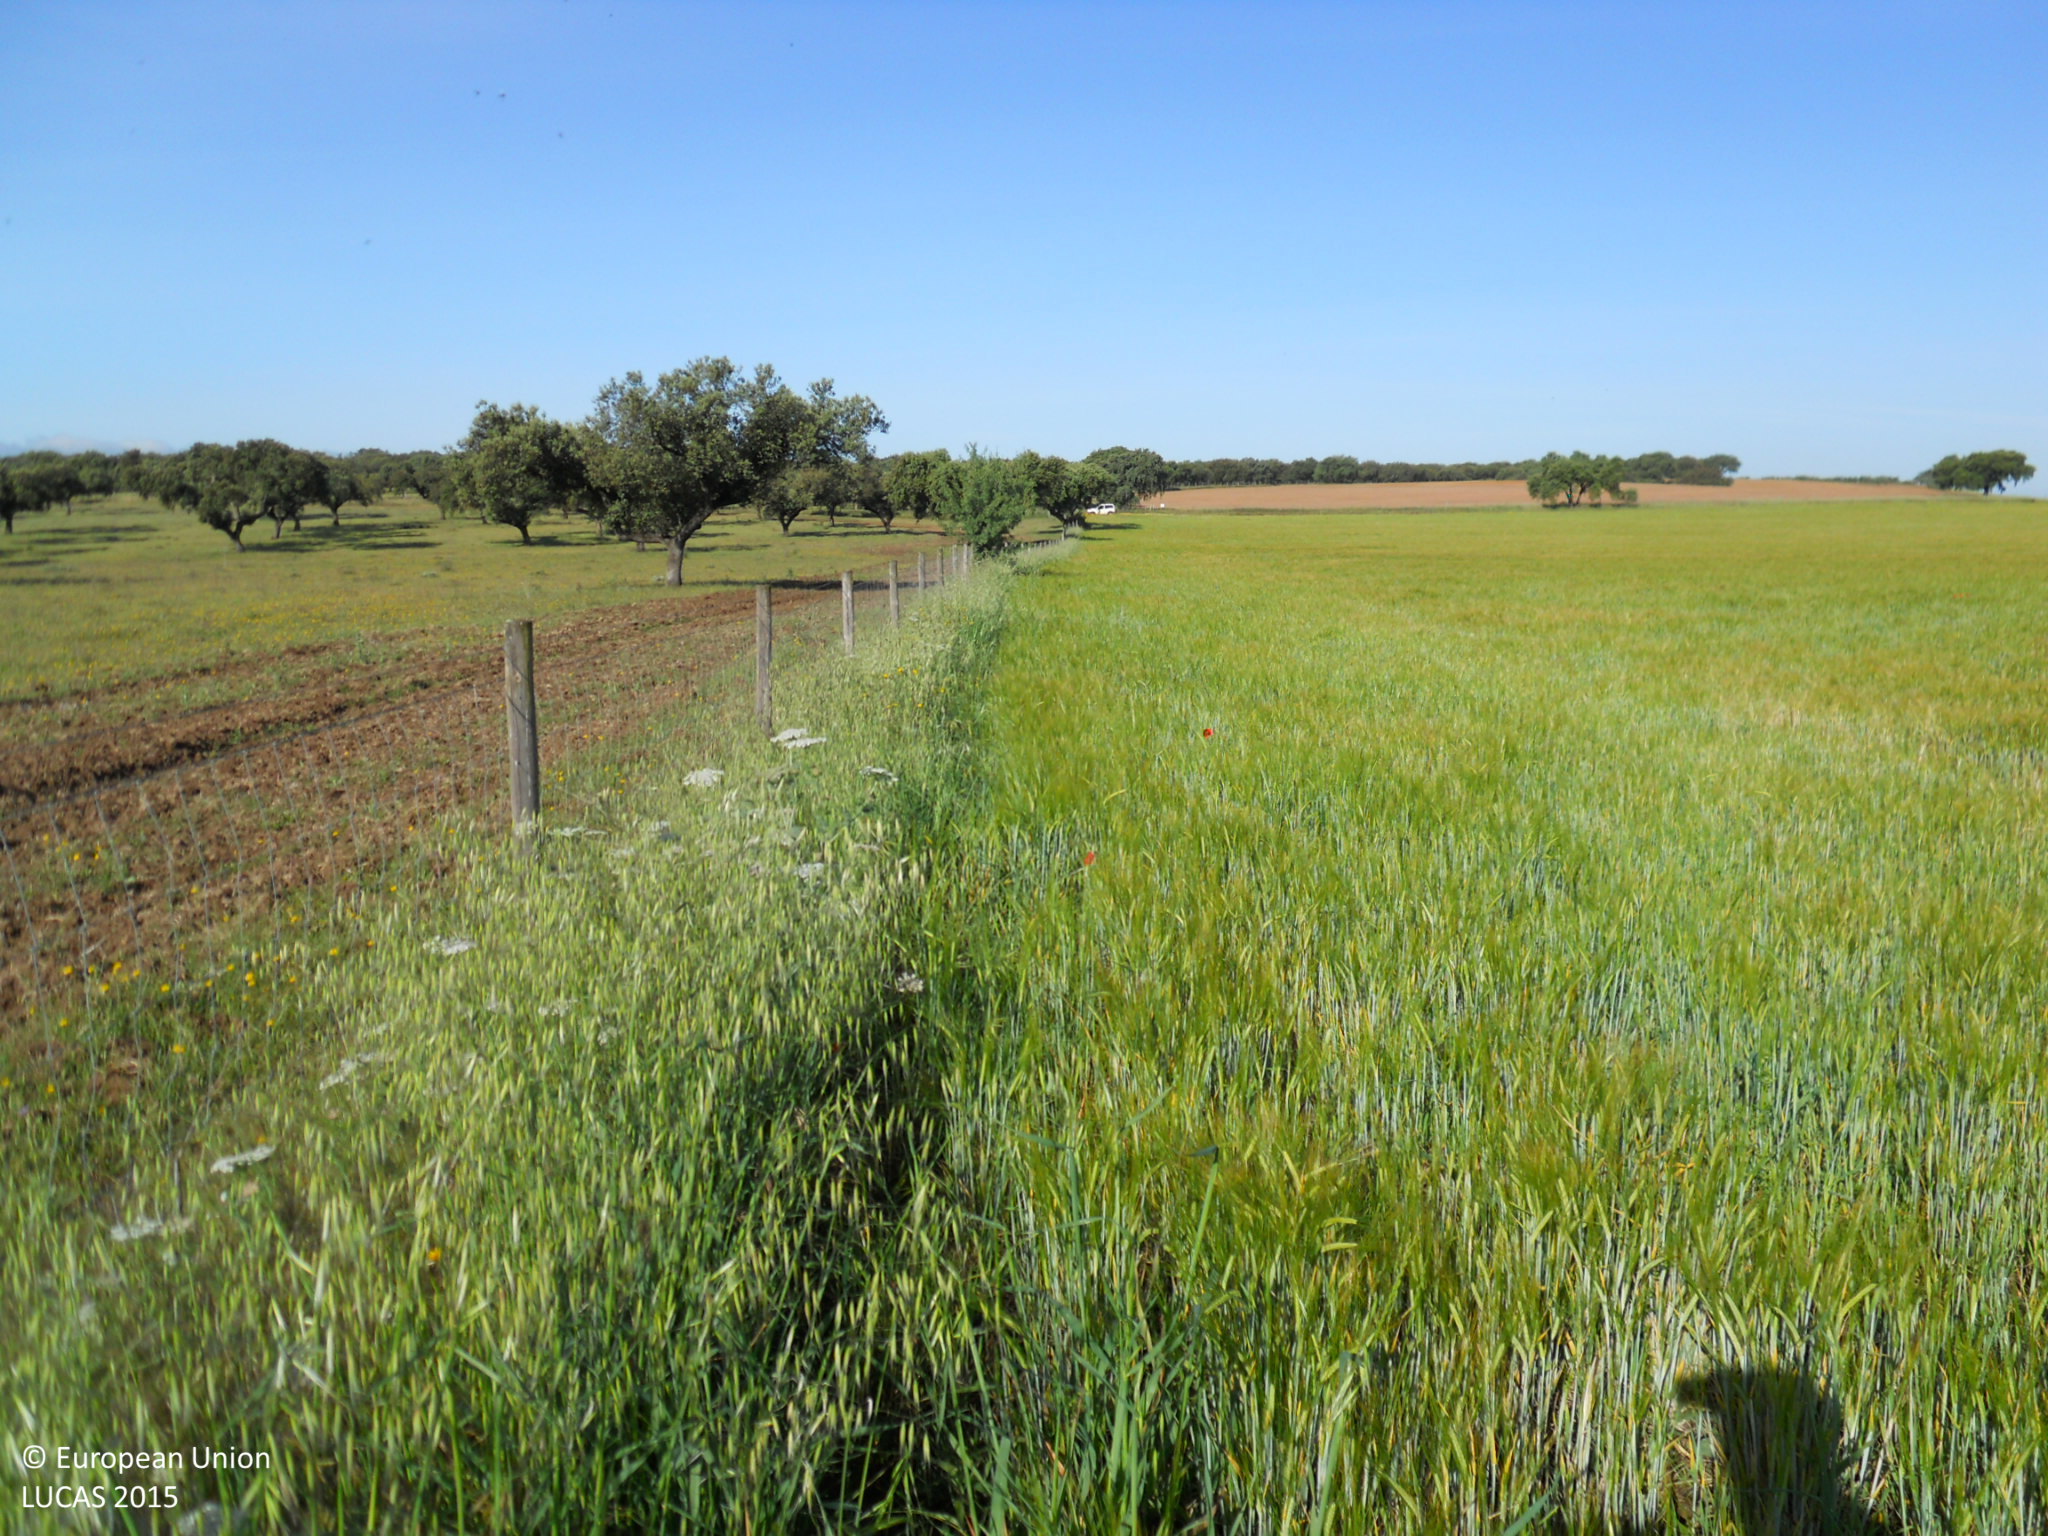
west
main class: Cropland
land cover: Barley
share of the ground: > 75 %
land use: Agriculture (excluding fallow land and kitchen gardens)
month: April
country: ES
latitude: 39.0759
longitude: -6.8429
